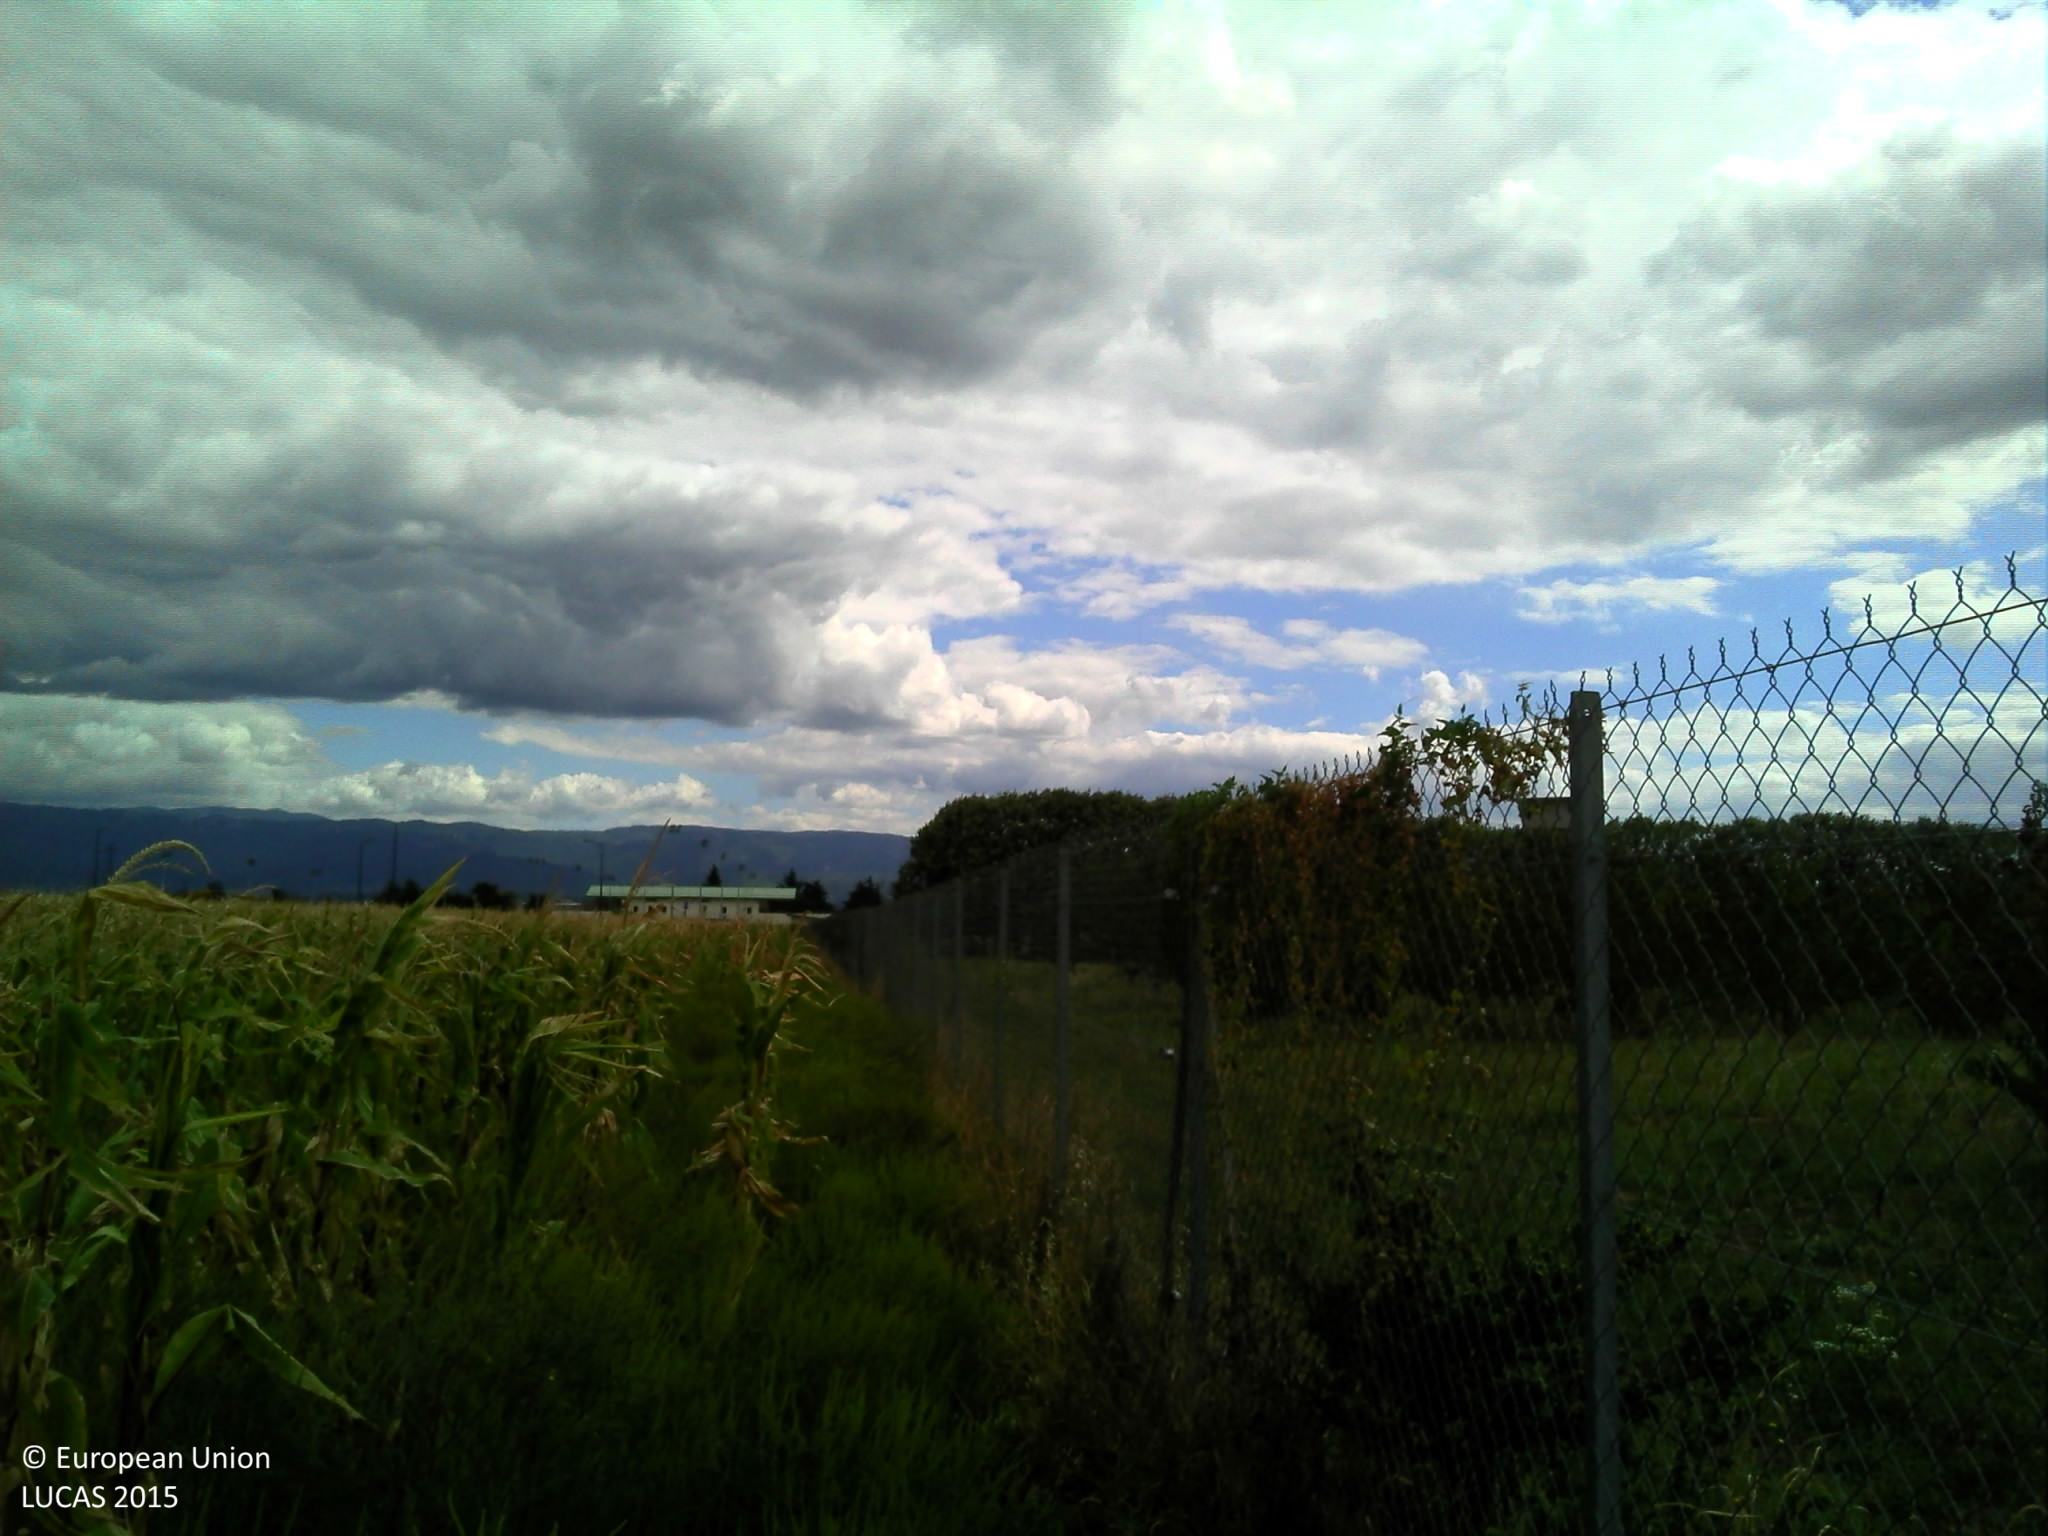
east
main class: Cropland
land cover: Maize
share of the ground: > 75 %
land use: Agriculture (excluding fallow land and kitchen gardens)
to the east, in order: Maize; Grassland without tree/shrub cover; Lines of trees; Grassland without tree/shrub cover; Lines of trees; Grassland without tree/shrub cover; Fences; Grass margins; Paved roads, cycling and walking lanes; Fences; Ditches and canals; Artificial constructions in urban areas
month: September
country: FR
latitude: 44.9130
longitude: 4.9265
